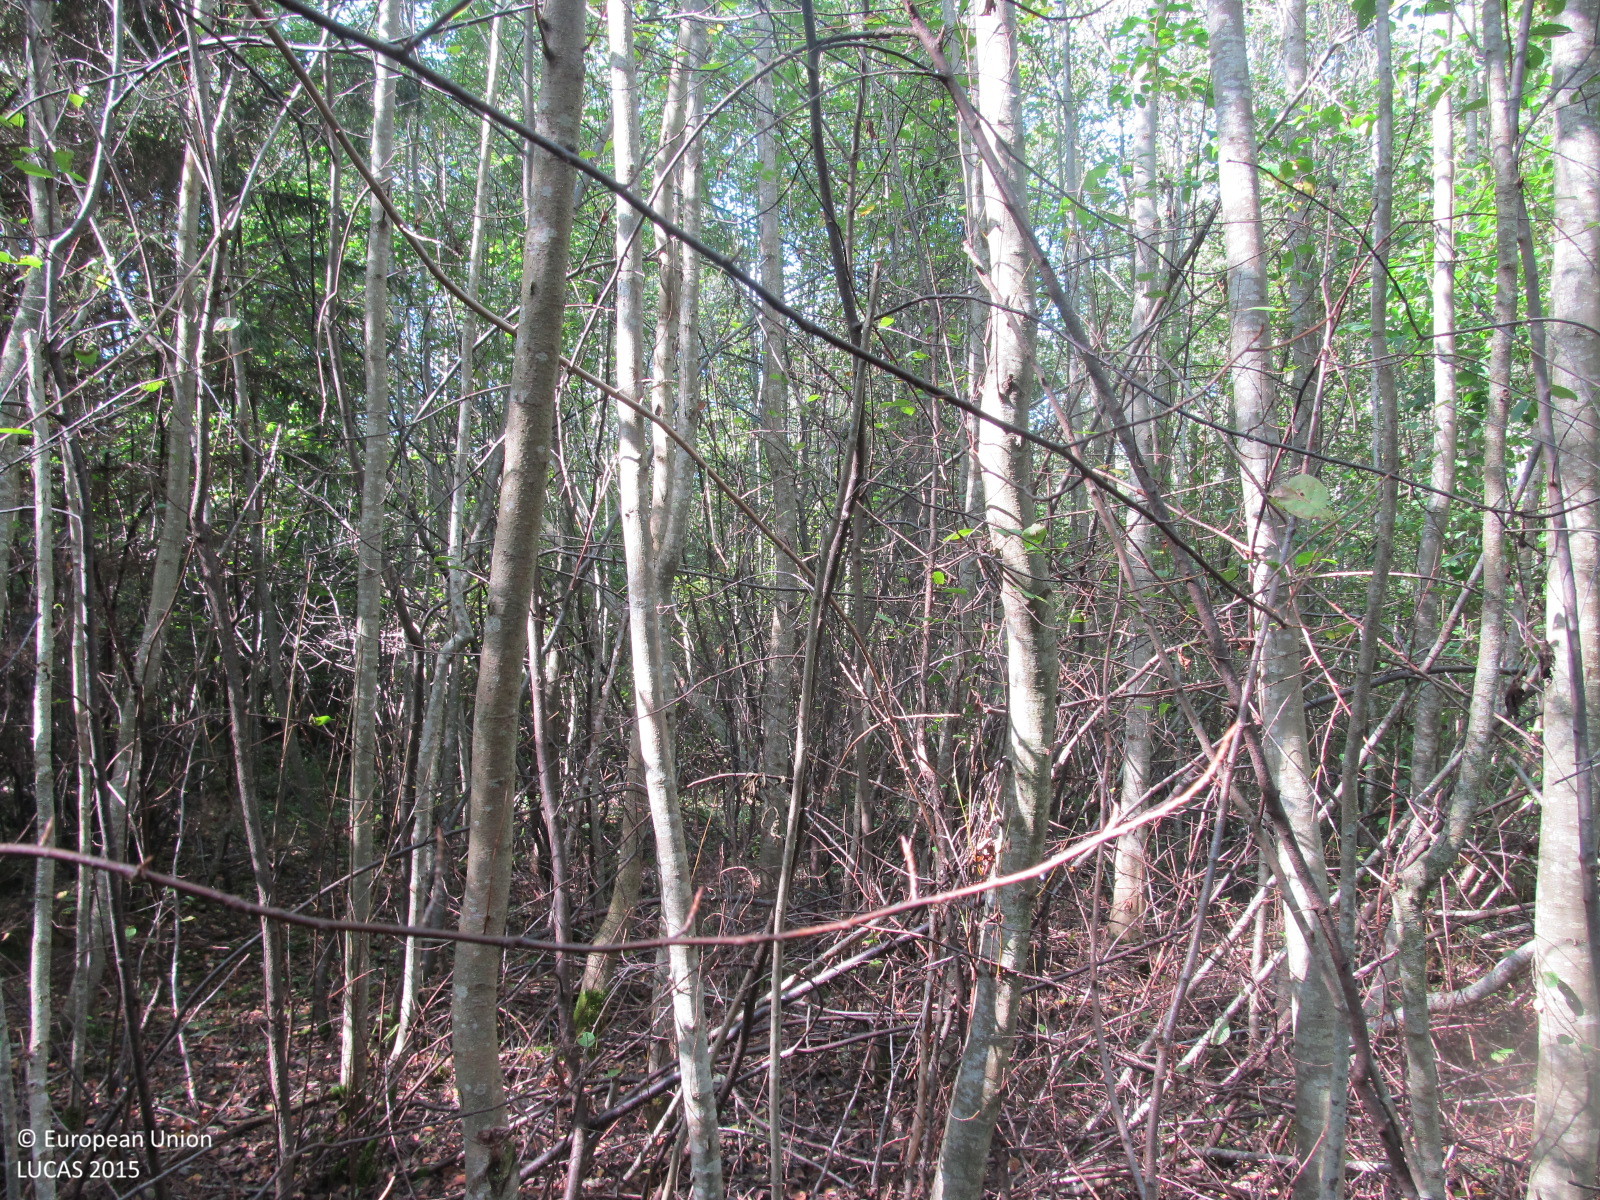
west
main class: Woodland
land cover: Broadleaved woodland
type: non-riverine alder, birch or aspen forest
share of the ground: > 75 %
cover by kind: broadleaved forest trees 85 %, shrubs 5 %, herbaceous plants 5 %, unconsolidated bare surface 5 %
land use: Forestry
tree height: > 5 m
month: September
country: LT
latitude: 56.0868
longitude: 23.3648
